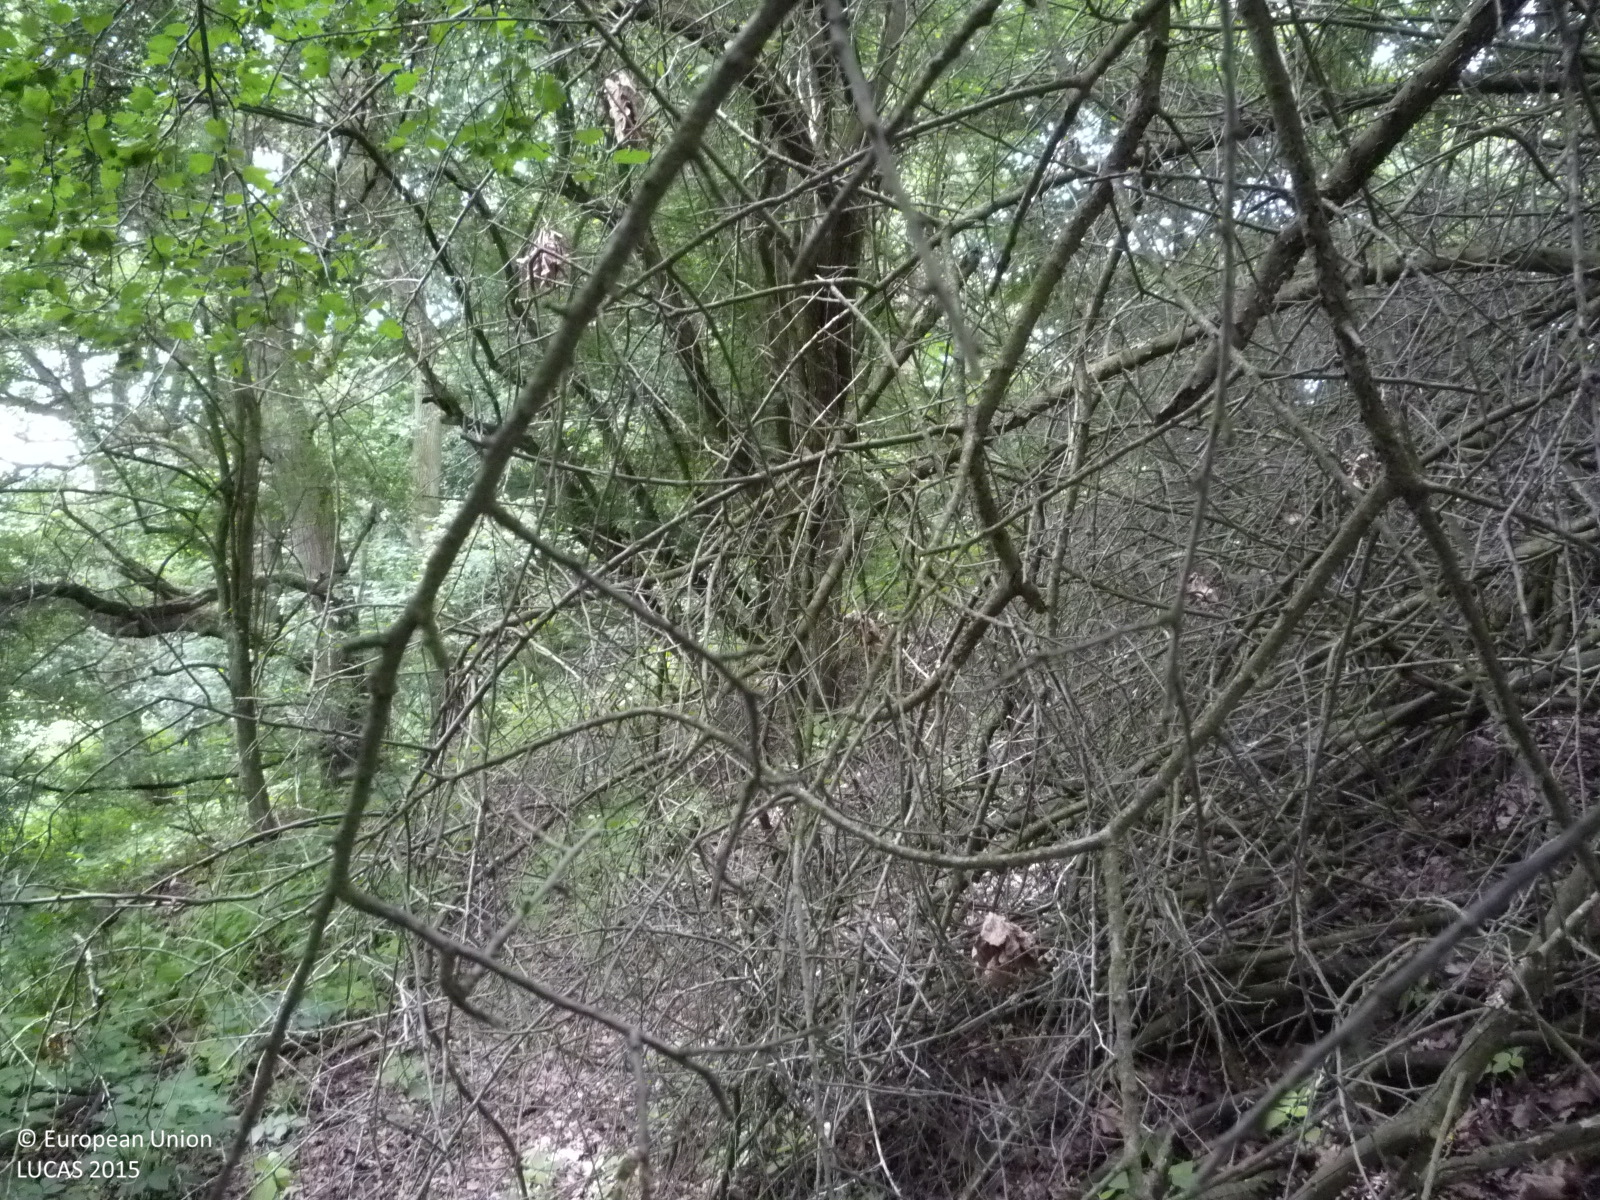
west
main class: Woodland
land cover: Broadleaved woodland
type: non-riverine alder, birch or aspen forest
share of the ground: > 75 %
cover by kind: broadleaved forest trees 75 %, coniferous forest trees 20 %, shrubs 5 %
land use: Semi-natural and natural areas not in use
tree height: > 5 m
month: June
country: CZ
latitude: 49.8678
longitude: 15.1926
